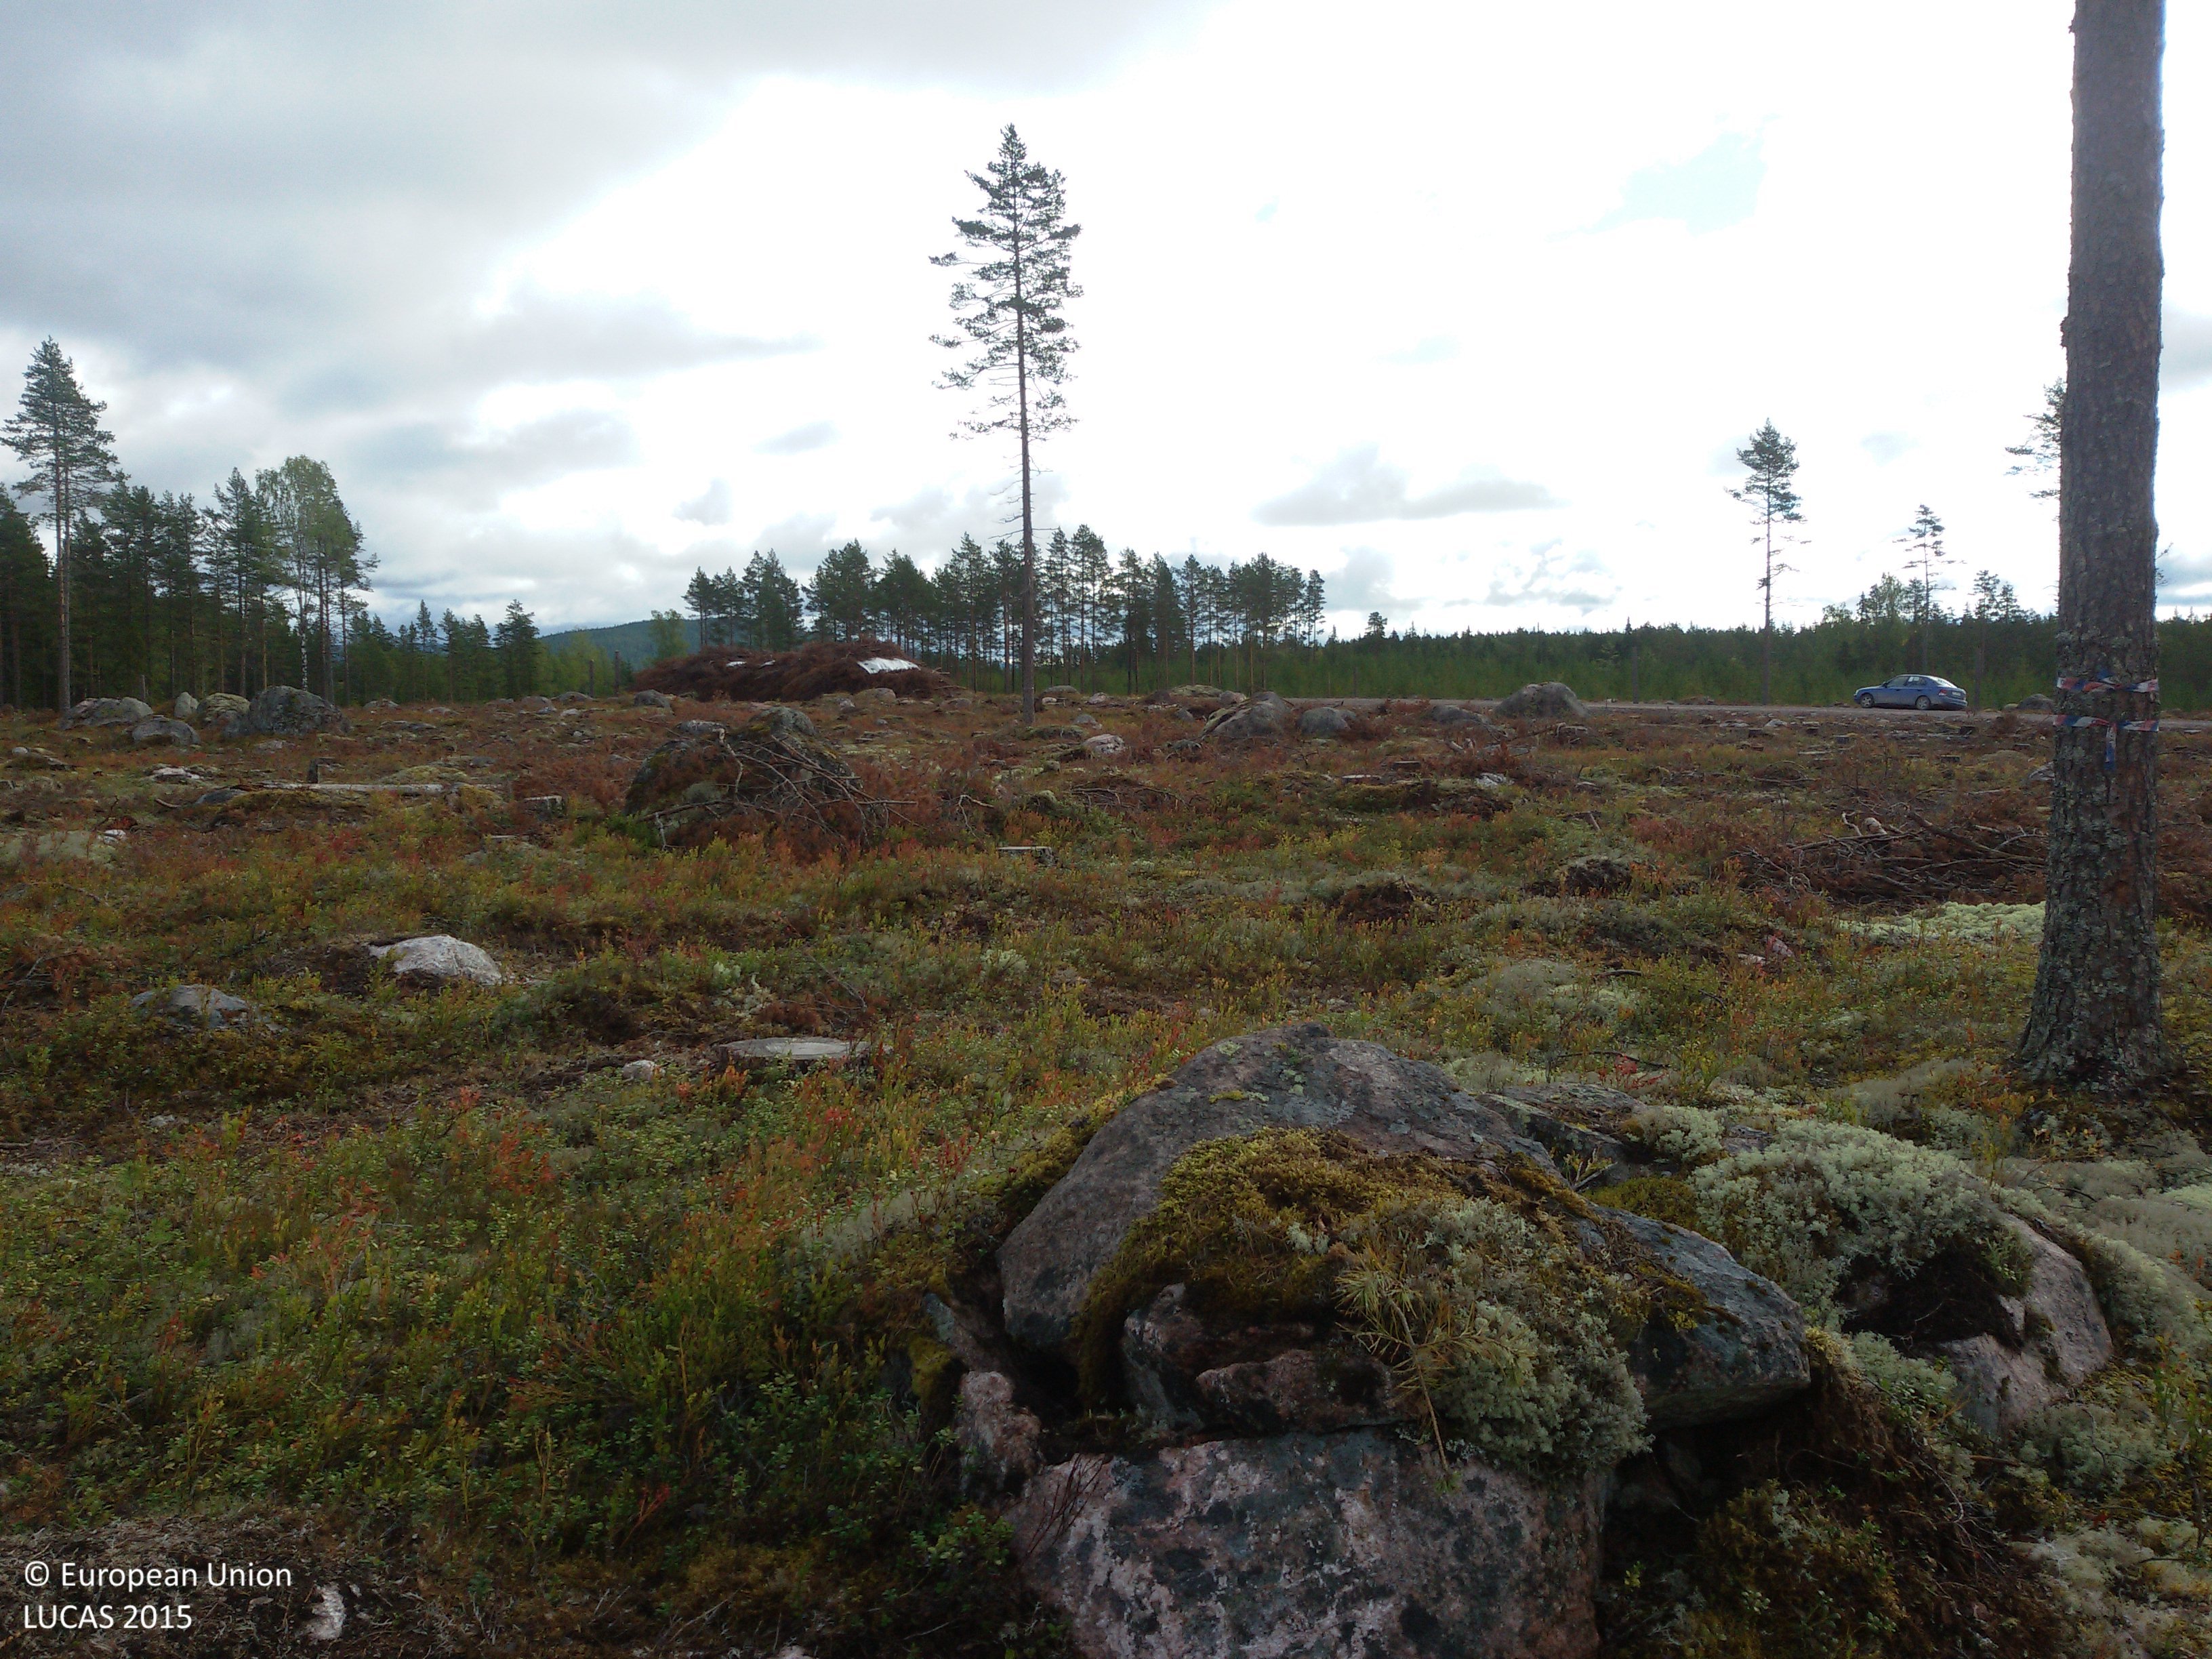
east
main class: Shrubland
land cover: Shrubland with sparse tree cover
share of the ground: 25 - 50 %
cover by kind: shrubs 35 %, lichens and mosses 25 %, unconsolidated bare surface 25 %, herbaceous plants 10 %, coniferous forest trees 5 %
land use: Forestry
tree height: < 5 m
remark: Clear cut
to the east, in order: Shrubland with sparse tree cover; Paved roads, cycling and walking lanes; Pine dominated coniferous woodland
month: September
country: SE
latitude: 61.0351
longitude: 15.3726
